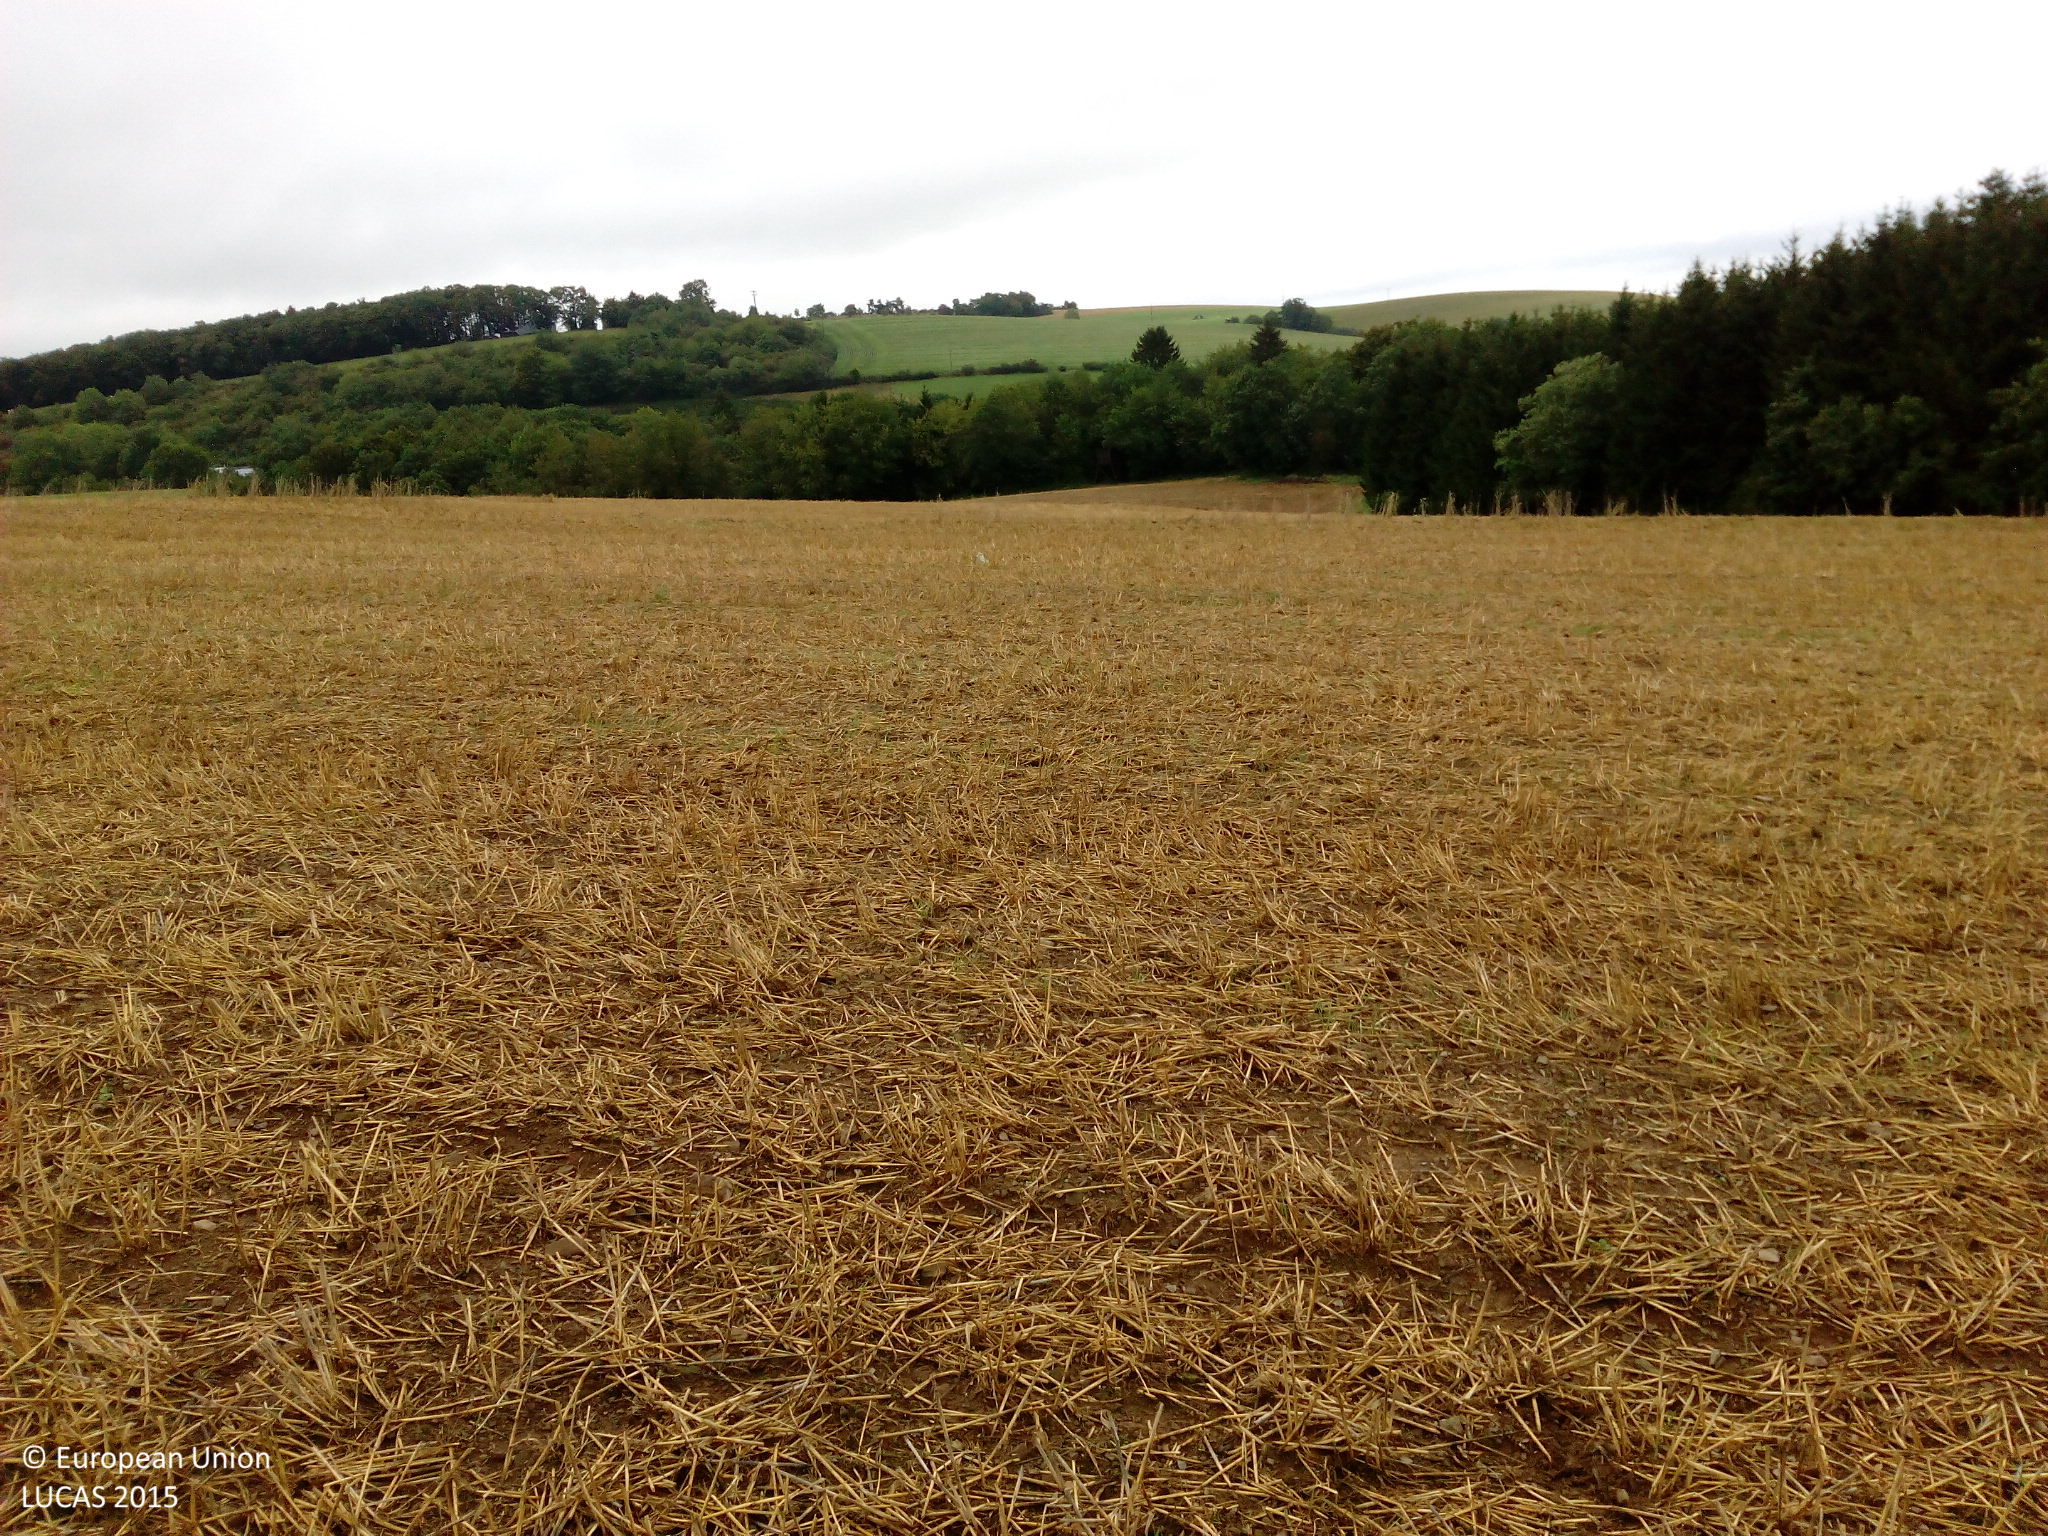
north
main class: Cropland
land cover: Rye
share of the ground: < 10 %
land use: Agriculture (excluding fallow land and kitchen gardens)
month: August
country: DE
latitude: 50.0522
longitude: 6.2984
